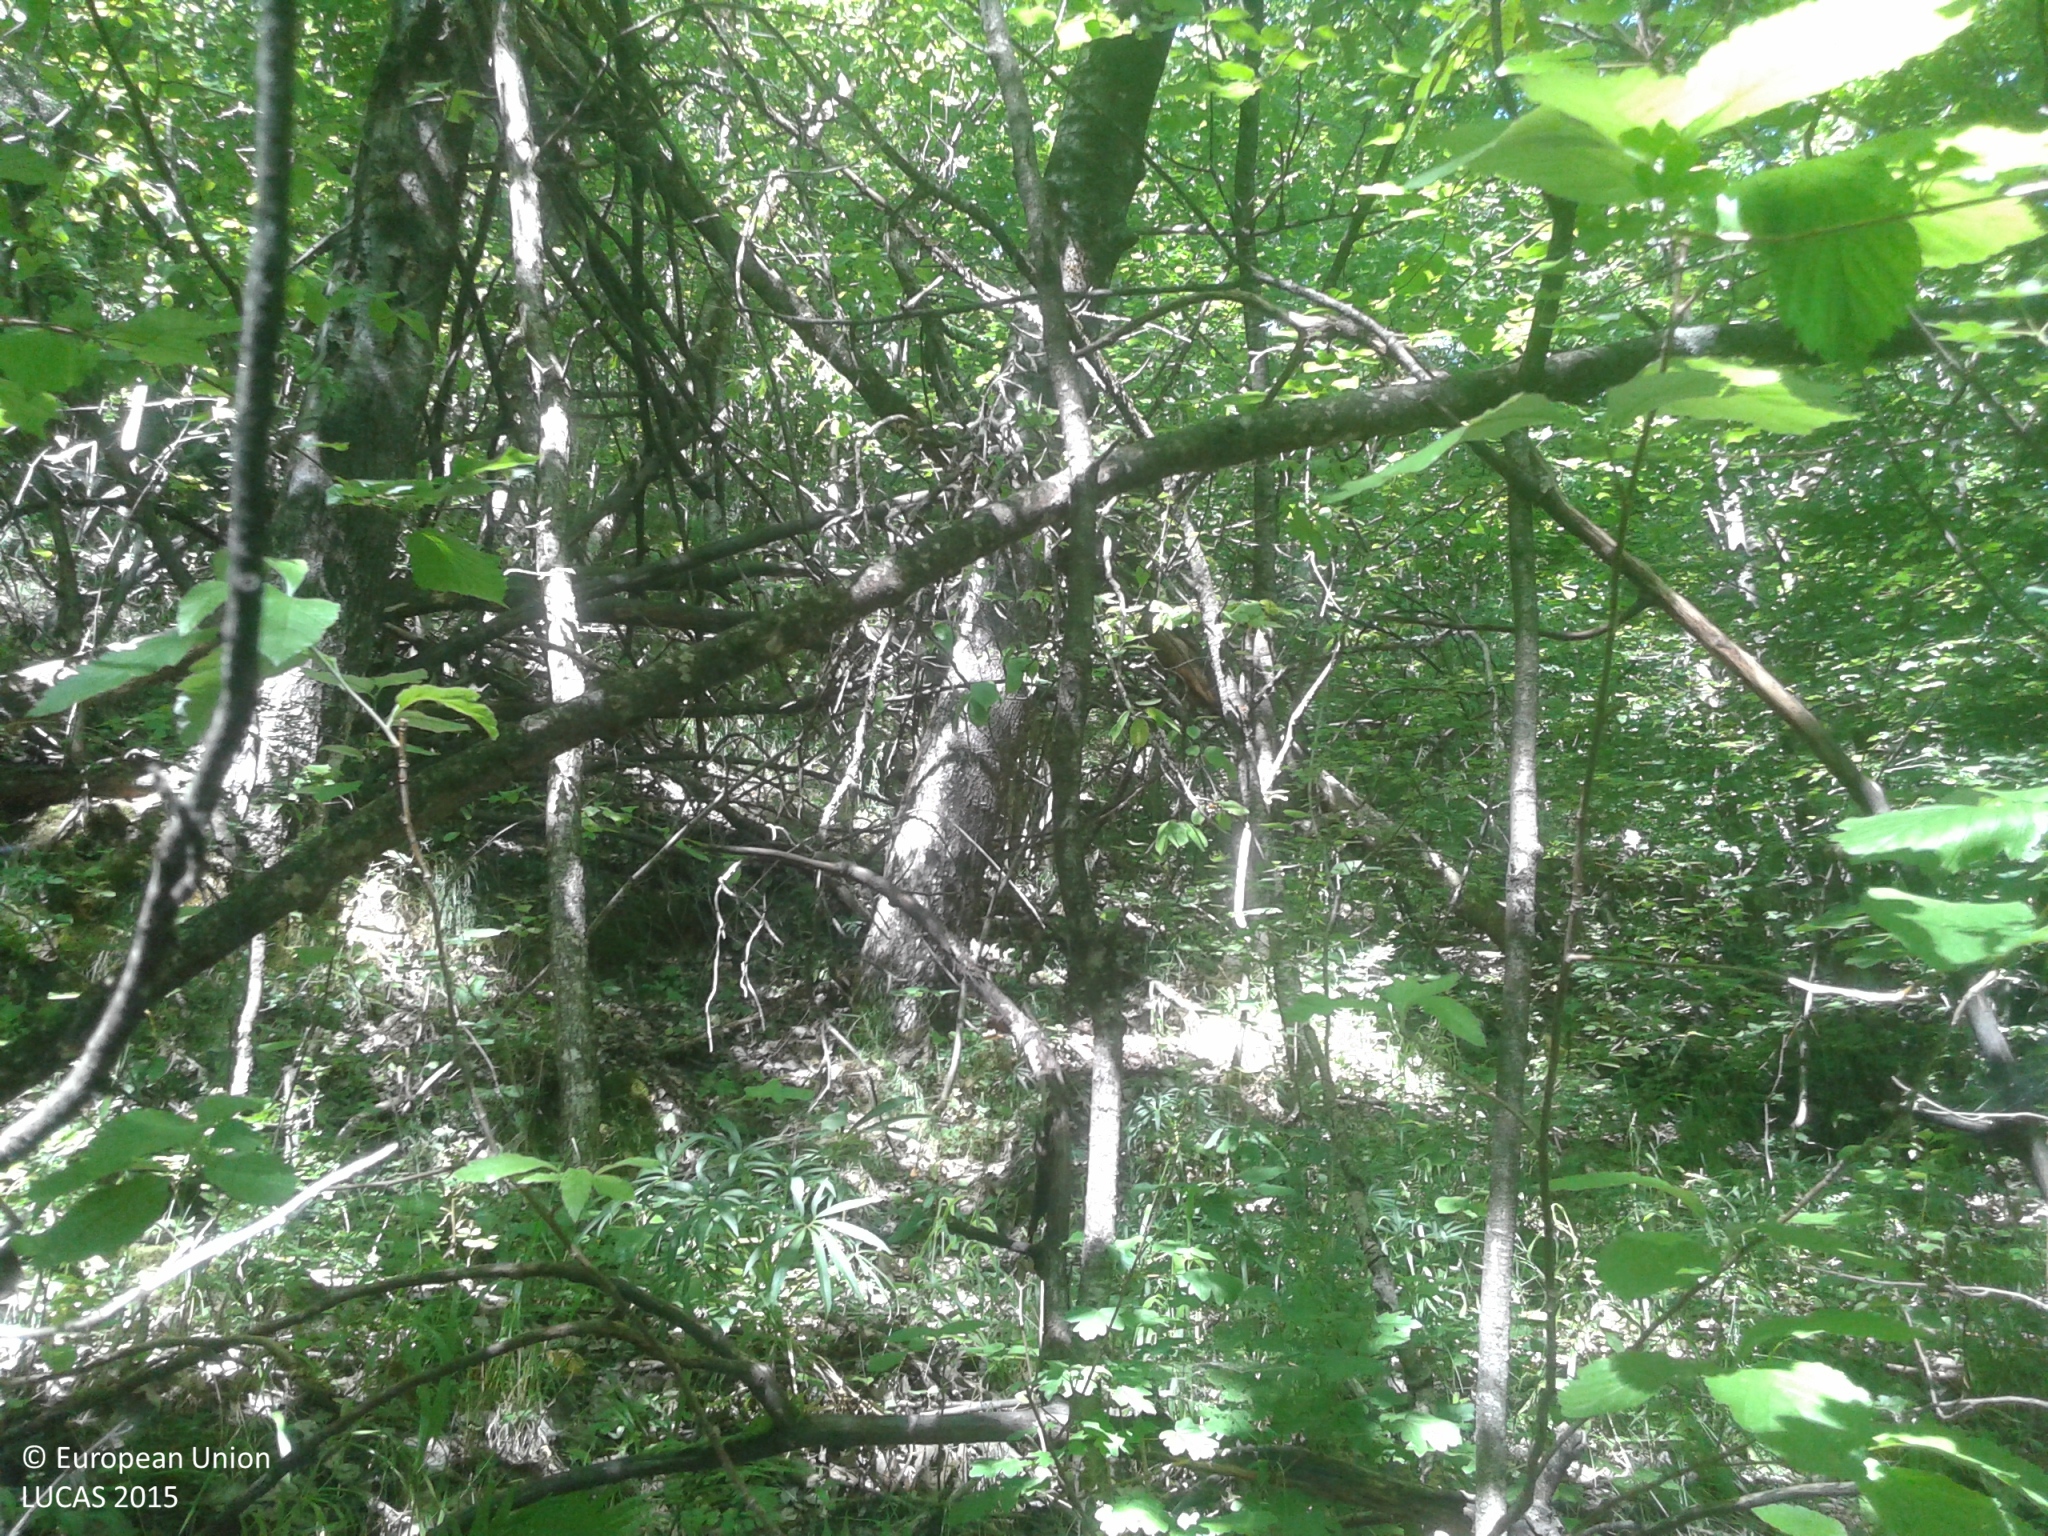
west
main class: Woodland
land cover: Broadleaved woodland
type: alpine coniferous forest
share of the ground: > 75 %
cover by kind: broadleaved forest trees 95 %, herbaceous plants 5 %
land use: Semi-natural and natural areas not in use
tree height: > 5 m
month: July
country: ES
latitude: 42.4407
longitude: 1.0725
